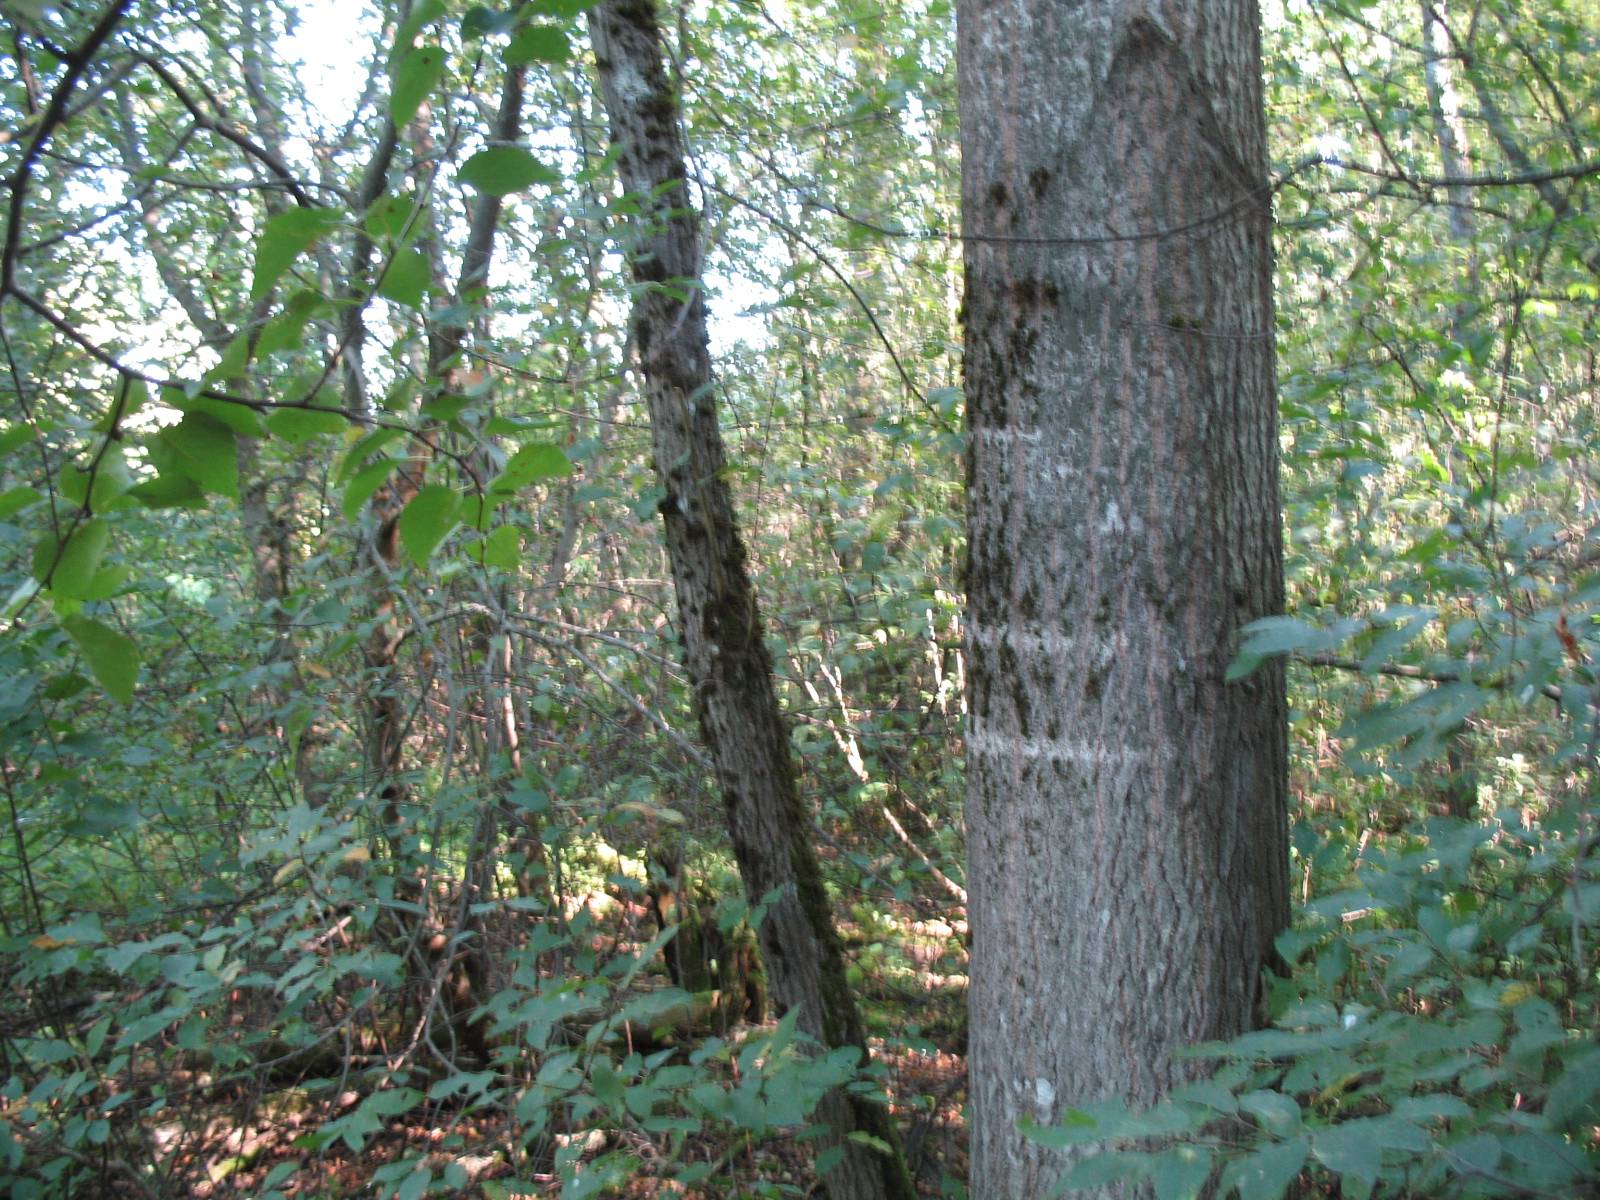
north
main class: Woodland
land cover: Broadleaved woodland
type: non-riverine alder, birch or aspen forest
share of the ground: 50 - 75 %
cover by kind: broadleaved forest trees 65 %, herbaceous plants 25 %, shrubs 10 %
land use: Forestry
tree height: > 5 m
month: August
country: LV
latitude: 56.4352
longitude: 25.6112
